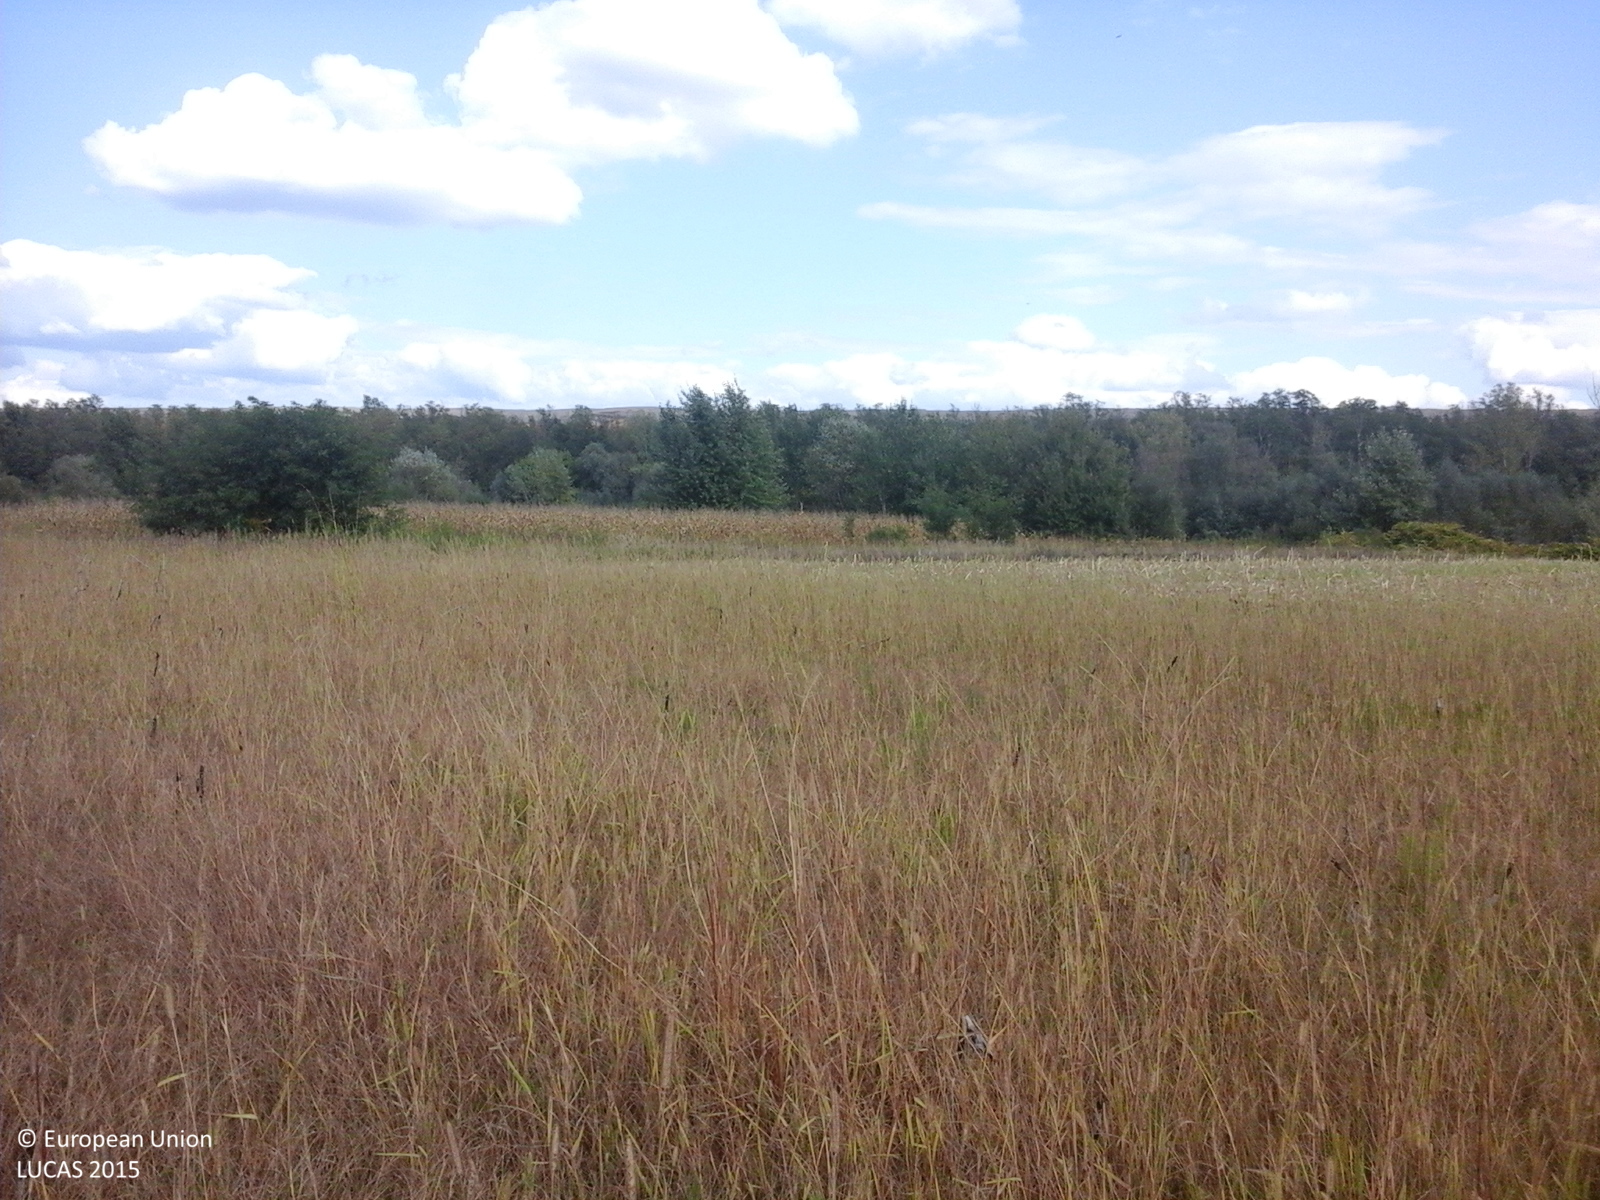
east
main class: Grassland
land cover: Spontaneously vegetated surfaces
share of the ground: > 75 %
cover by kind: herbaceous plants 100 %
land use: Fallow land
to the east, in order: Spontaneously vegetated surfaces; Maize; Spontaneously vegetated surfaces; Tracks; Abandoned hedges; Inland fresh running water; Spontaneously vegetated surfaces; Broadleaved woodland
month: September
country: RO
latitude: 47.6320
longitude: 23.4487
